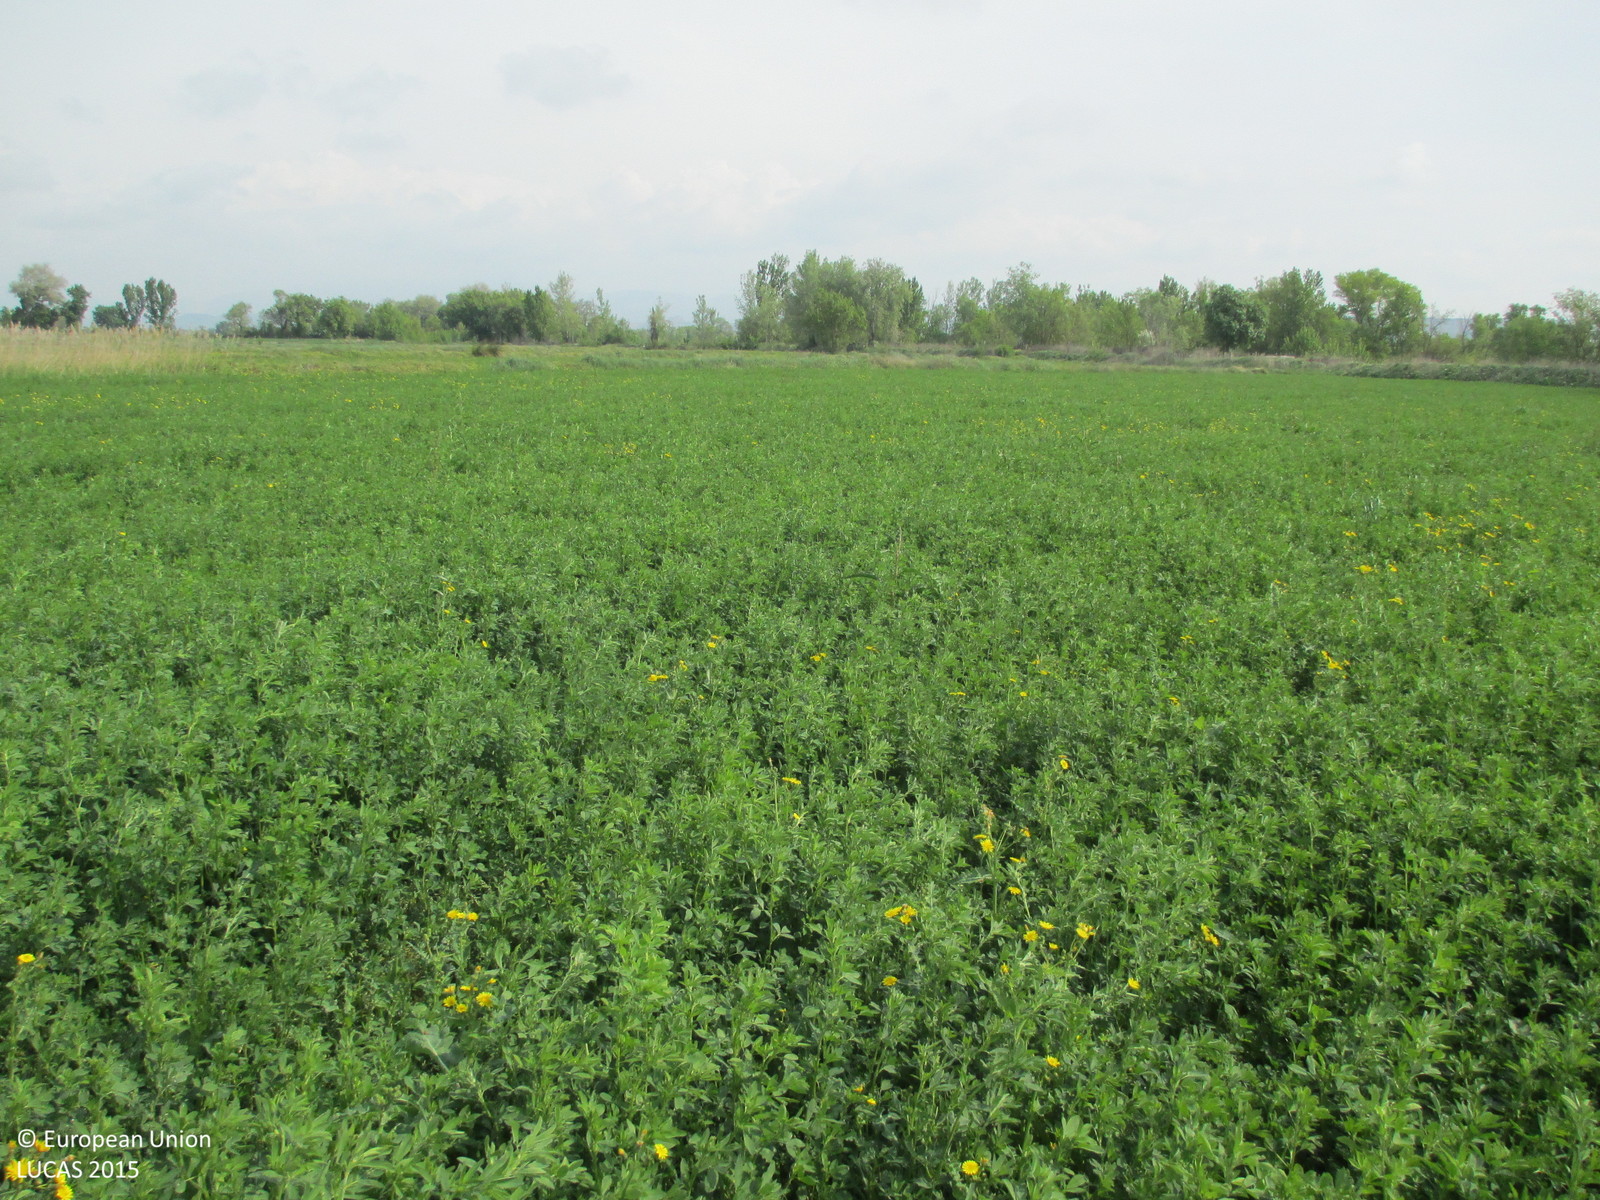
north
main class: Cropland
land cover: Lucerne
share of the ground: > 75 %
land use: Agriculture (excluding fallow land and kitchen gardens)
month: April
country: ES
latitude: 42.0827
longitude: -0.3817
